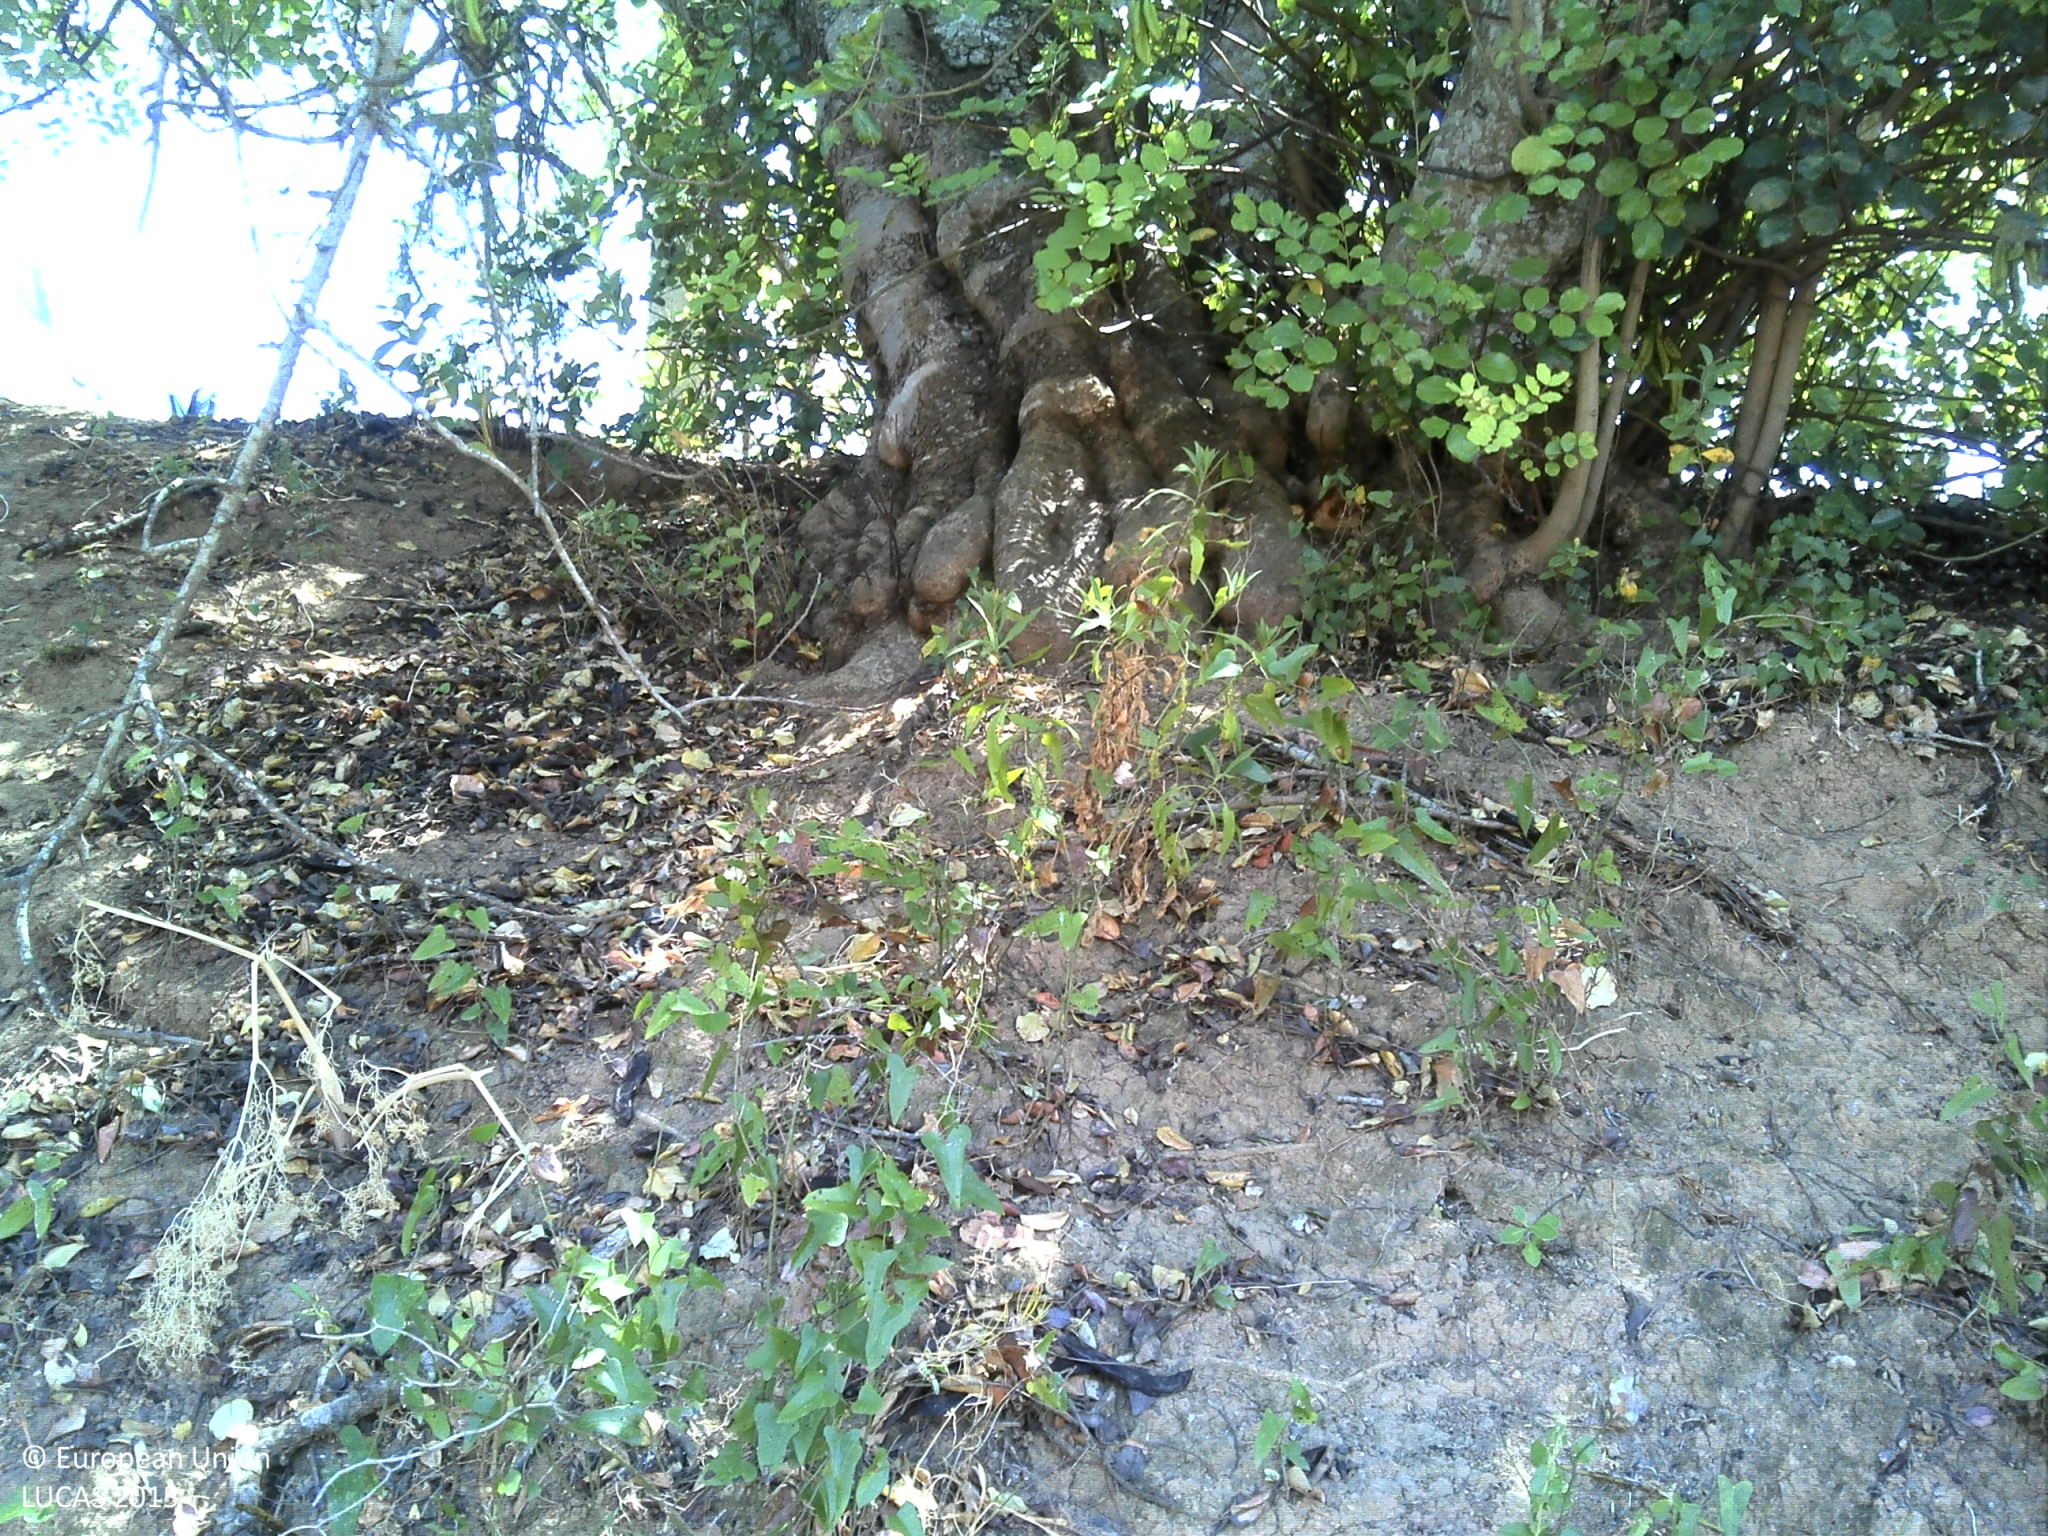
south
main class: Cropland
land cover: Permanent industrial crops
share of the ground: < 10 %
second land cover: Spontaneously vegetated surfaces
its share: 10 - 25 %
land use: Agriculture (excluding fallow land and kitchen gardens)
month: June
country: PT
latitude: 37.1524
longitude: -7.7641
